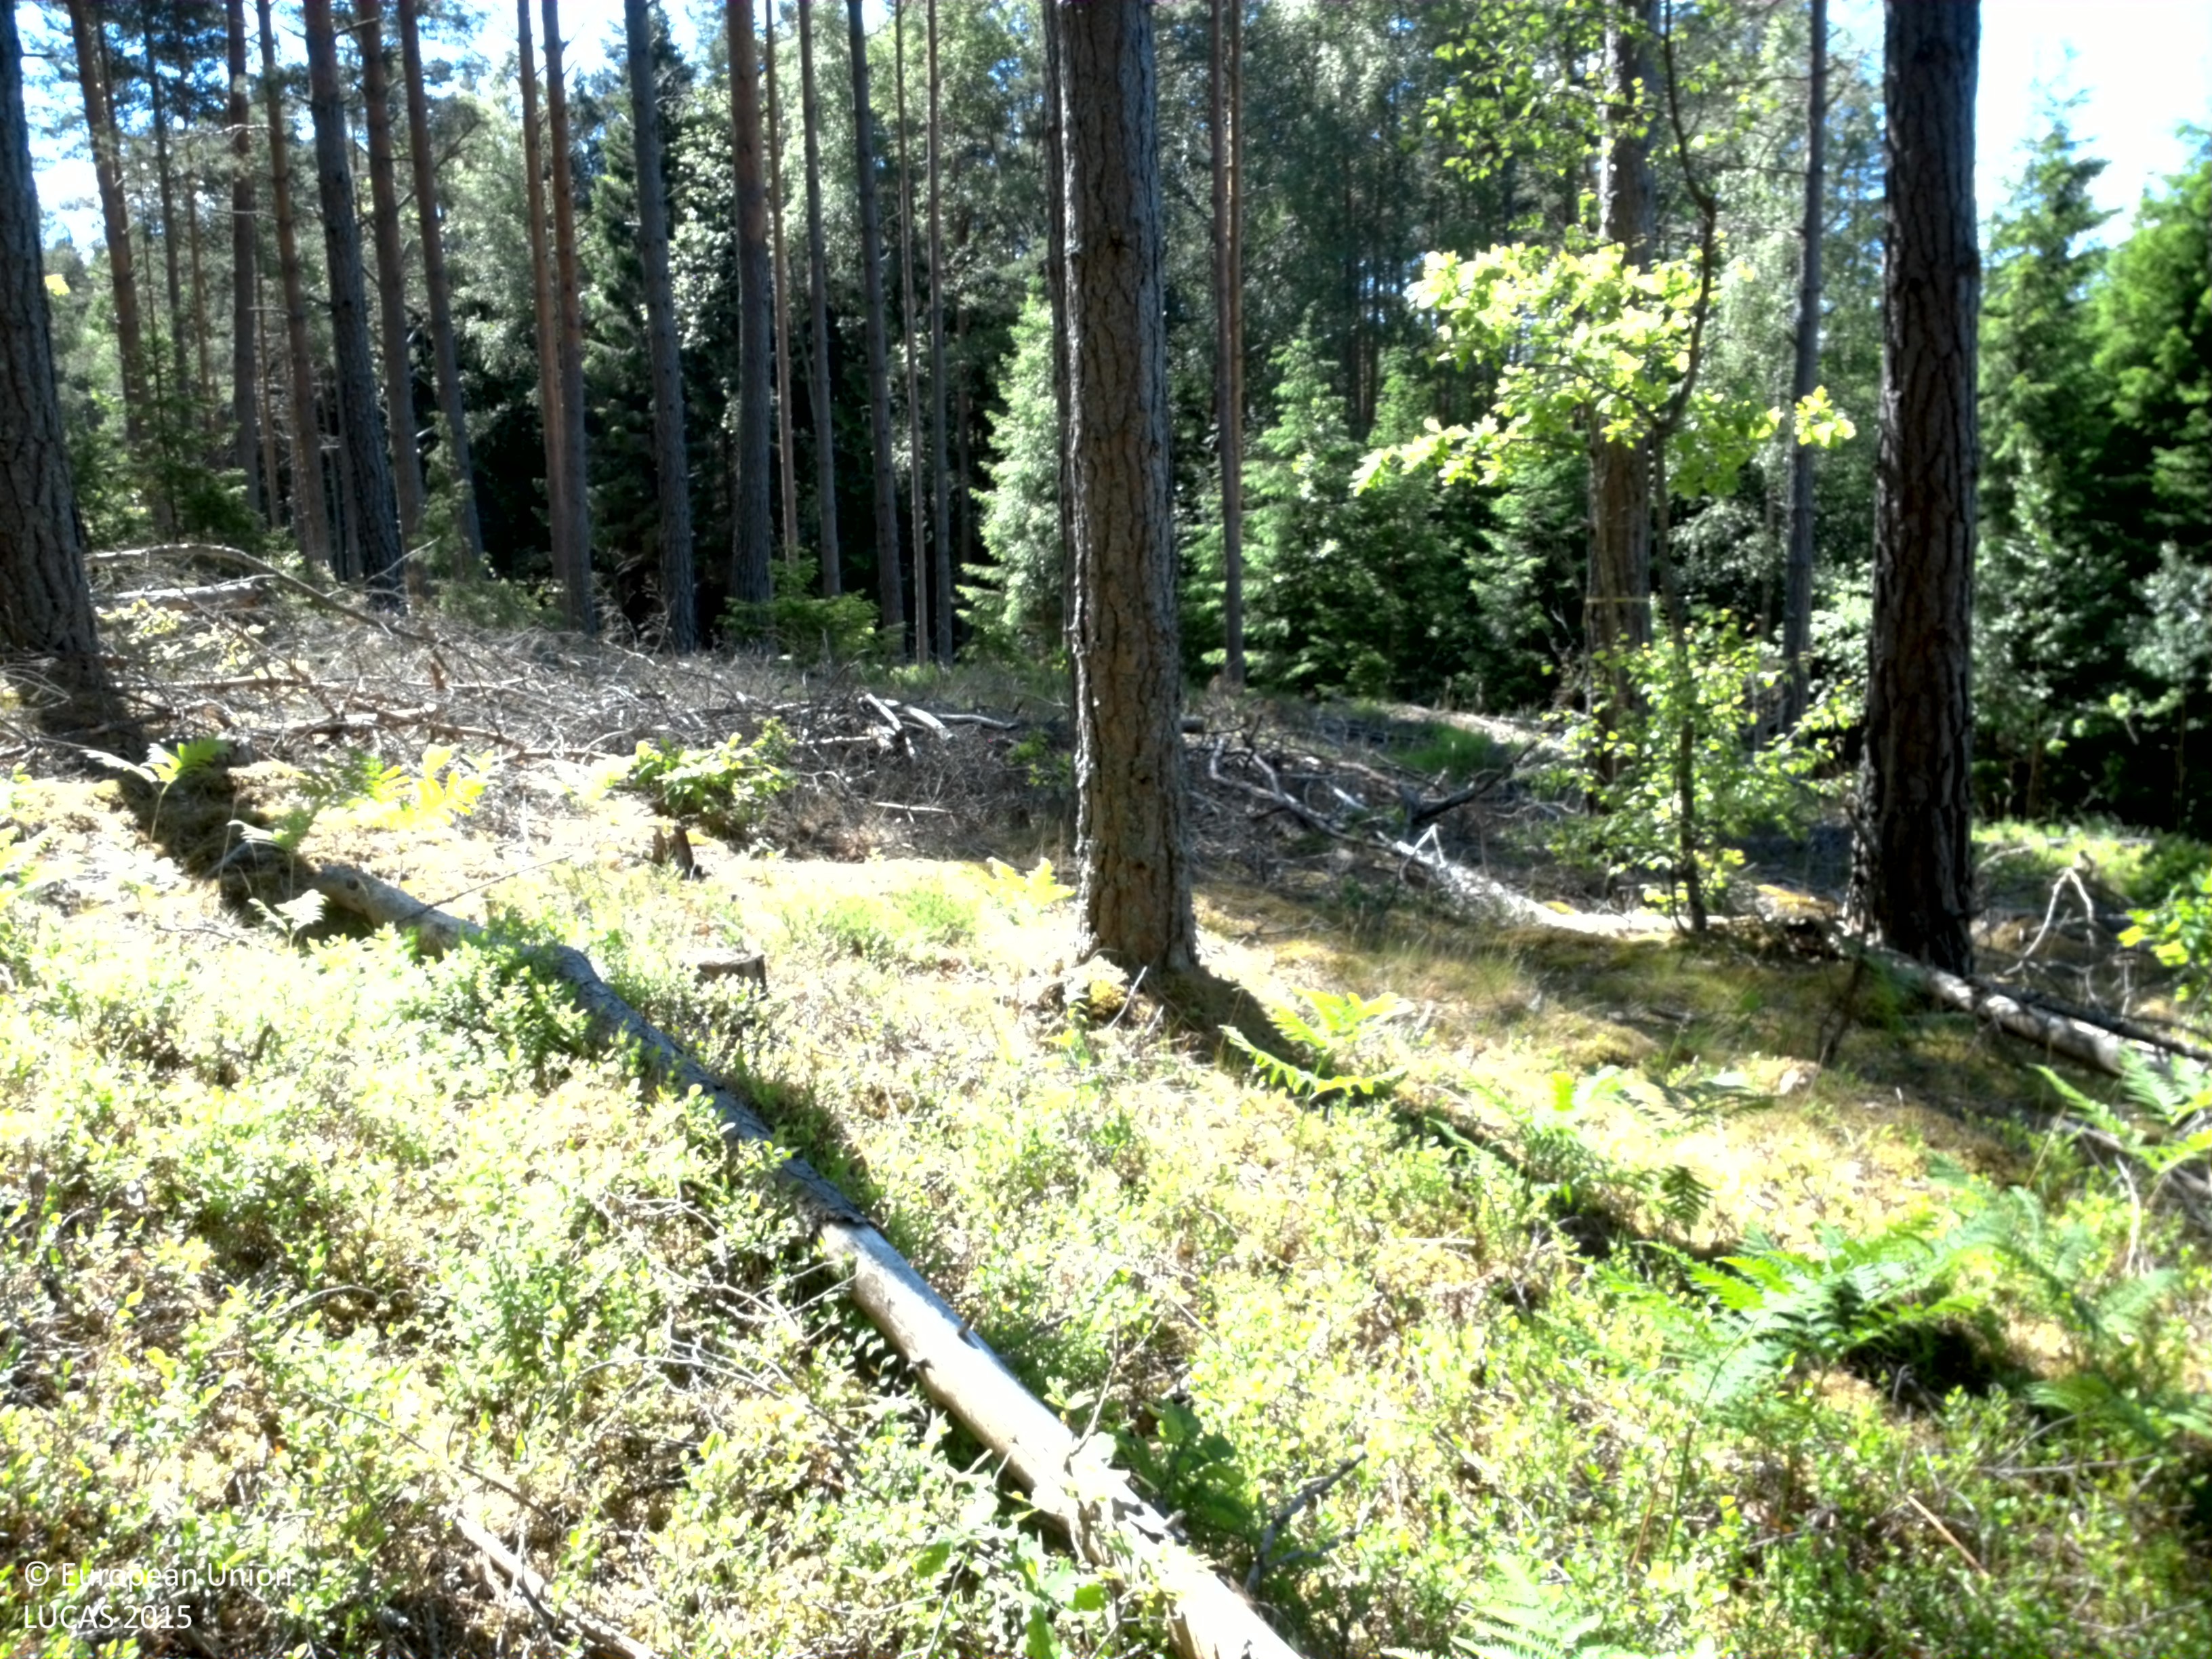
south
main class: Woodland
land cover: Pine dominated coniferous woodland
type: boreal forest
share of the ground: 25 - 50 %
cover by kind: herbaceous plants 35 %, coniferous forest trees 30 %, lichens and mosses 30 %, broadleaved forest trees 5 %
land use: Forestry
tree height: > 5 m
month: June
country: SE
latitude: 58.4110
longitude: 16.3803
